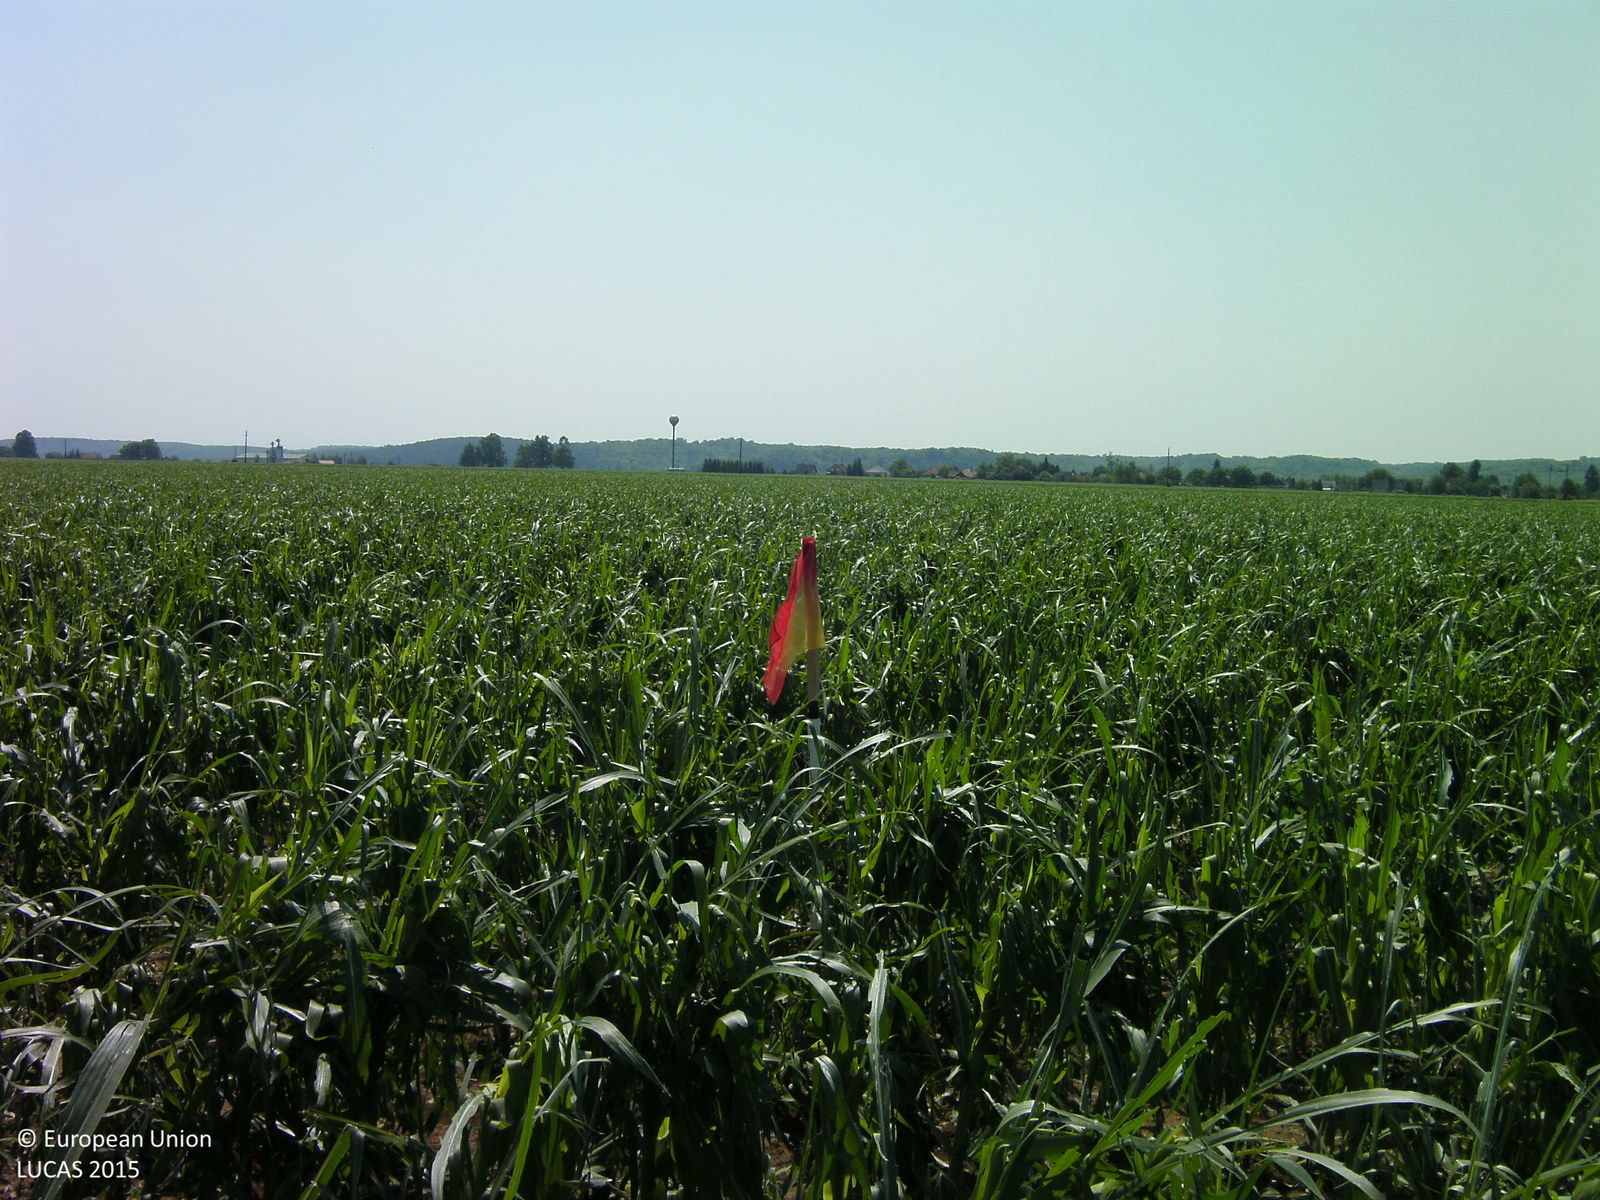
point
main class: Cropland
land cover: Maize
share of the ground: 50 - 75 %
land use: Agriculture (excluding fallow land and kitchen gardens)
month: June
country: HU
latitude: 46.3748
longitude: 18.0284
